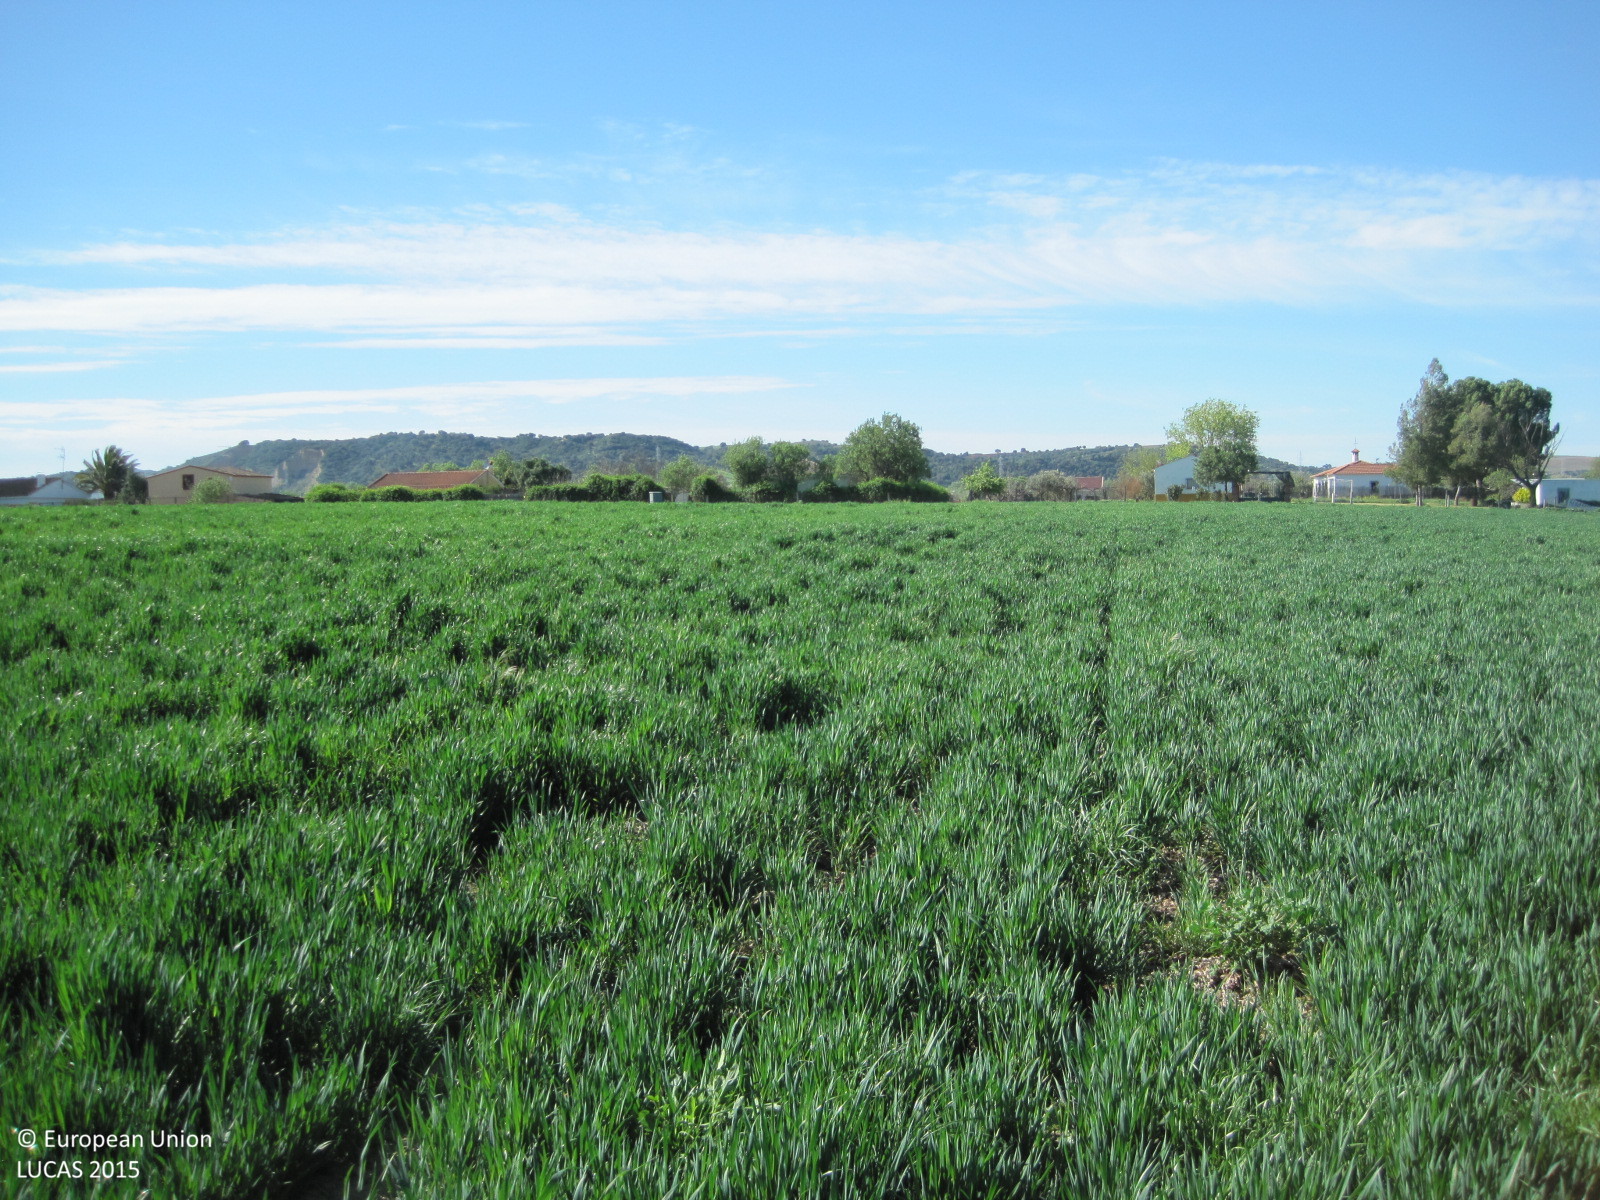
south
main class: Cropland
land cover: Barley
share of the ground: > 75 %
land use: Agriculture (excluding fallow land and kitchen gardens)
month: April
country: ES
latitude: 39.9696
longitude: -4.7639
